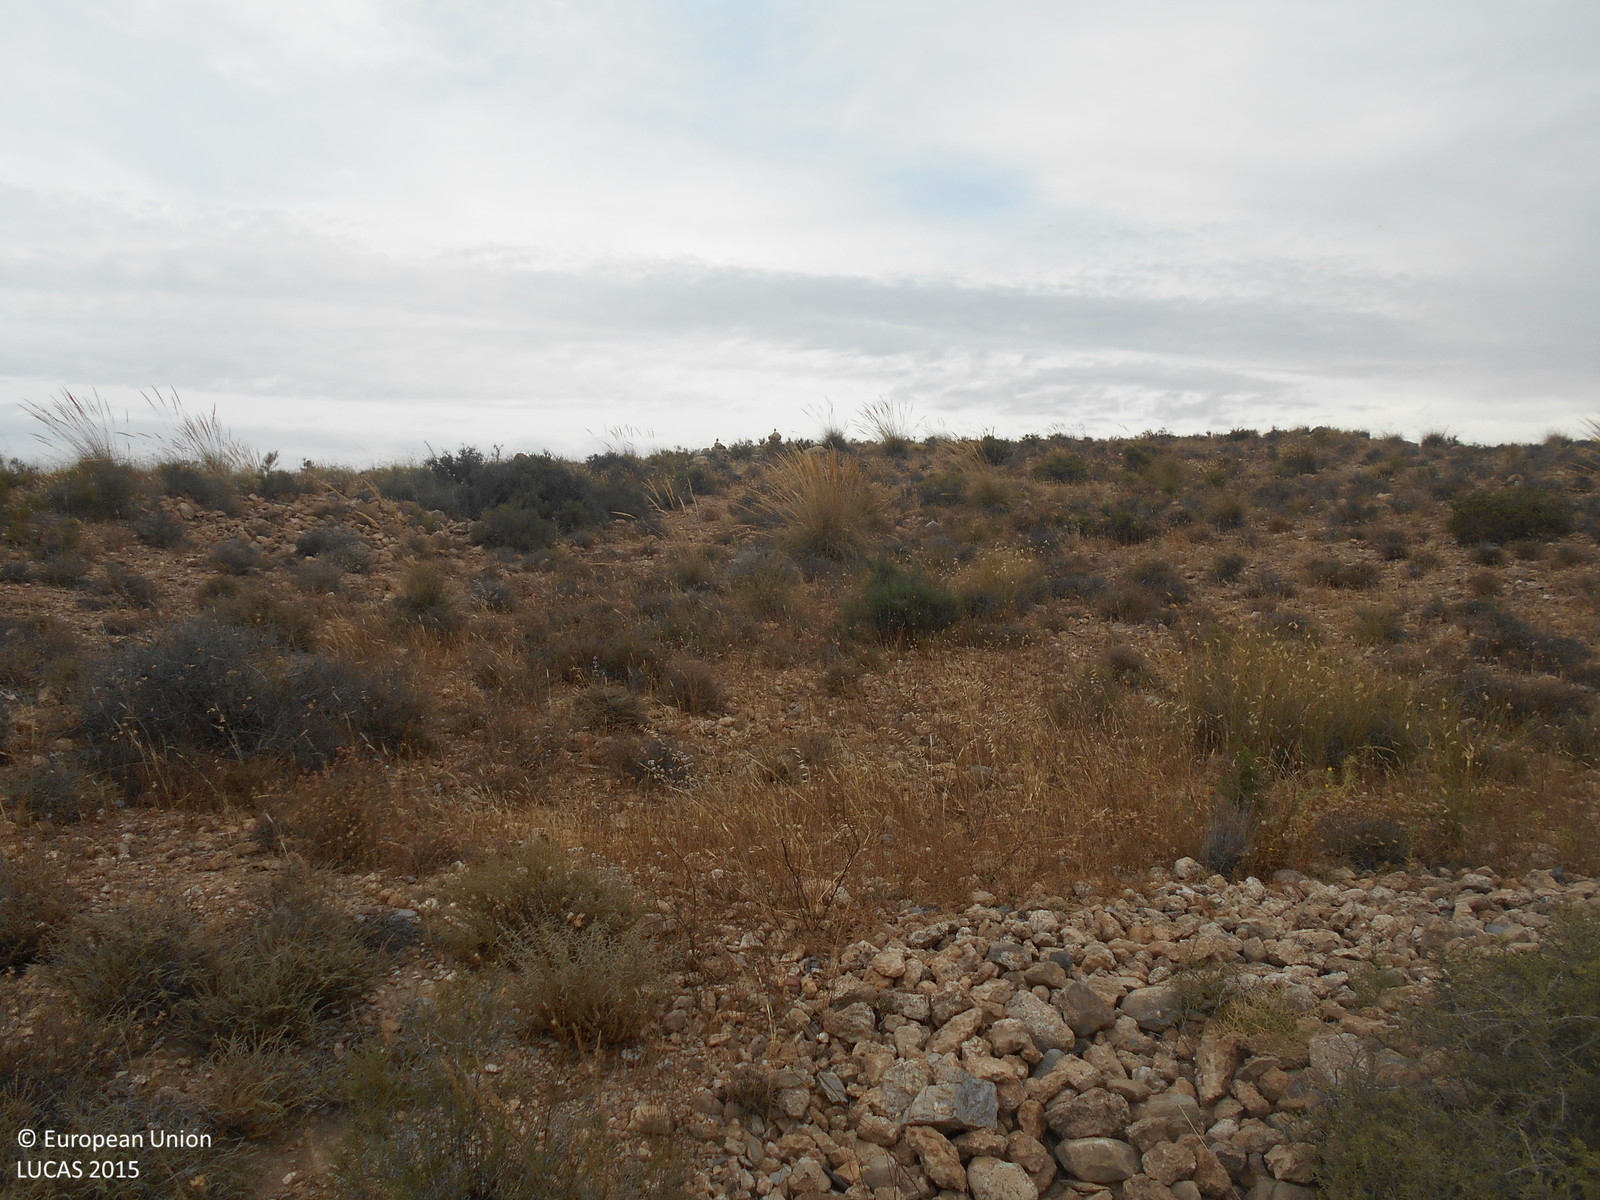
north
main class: Shrubland
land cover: Shrubland without tree cover
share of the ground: 10 - 25 %
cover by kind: unconsolidated bare surface 40 %, herbaceous plants 30 %, shrubs 20 %, consolidated bare surface 10 %
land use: Semi-natural and natural areas not in use
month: May
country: ES
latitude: 36.8928
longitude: -2.2846
